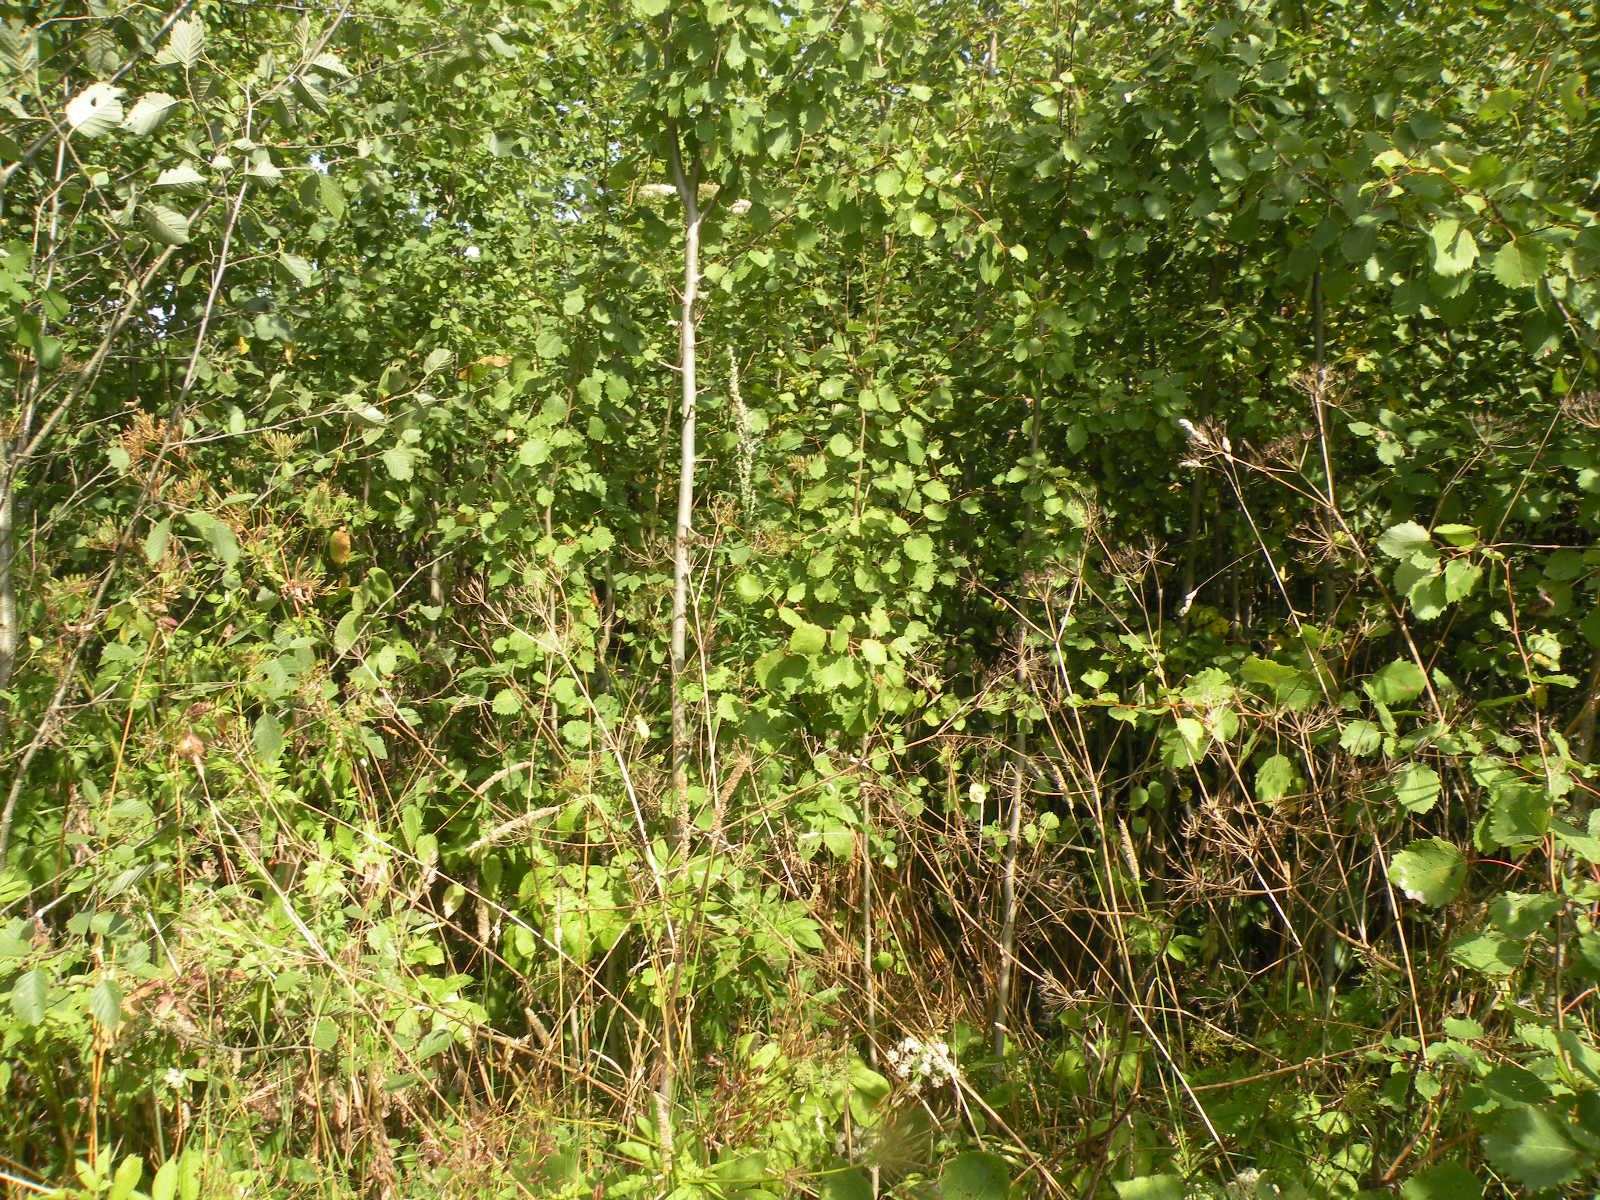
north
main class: Woodland
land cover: Broadleaved woodland
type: non-riverine alder, birch or aspen forest
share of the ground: > 75 %
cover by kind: broadleaved forest trees 75 %, herbaceous plants 15 %, shrubs 10 %
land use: Forestry
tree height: > 5 m
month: August
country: LV
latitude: 55.8689
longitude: 26.1697
